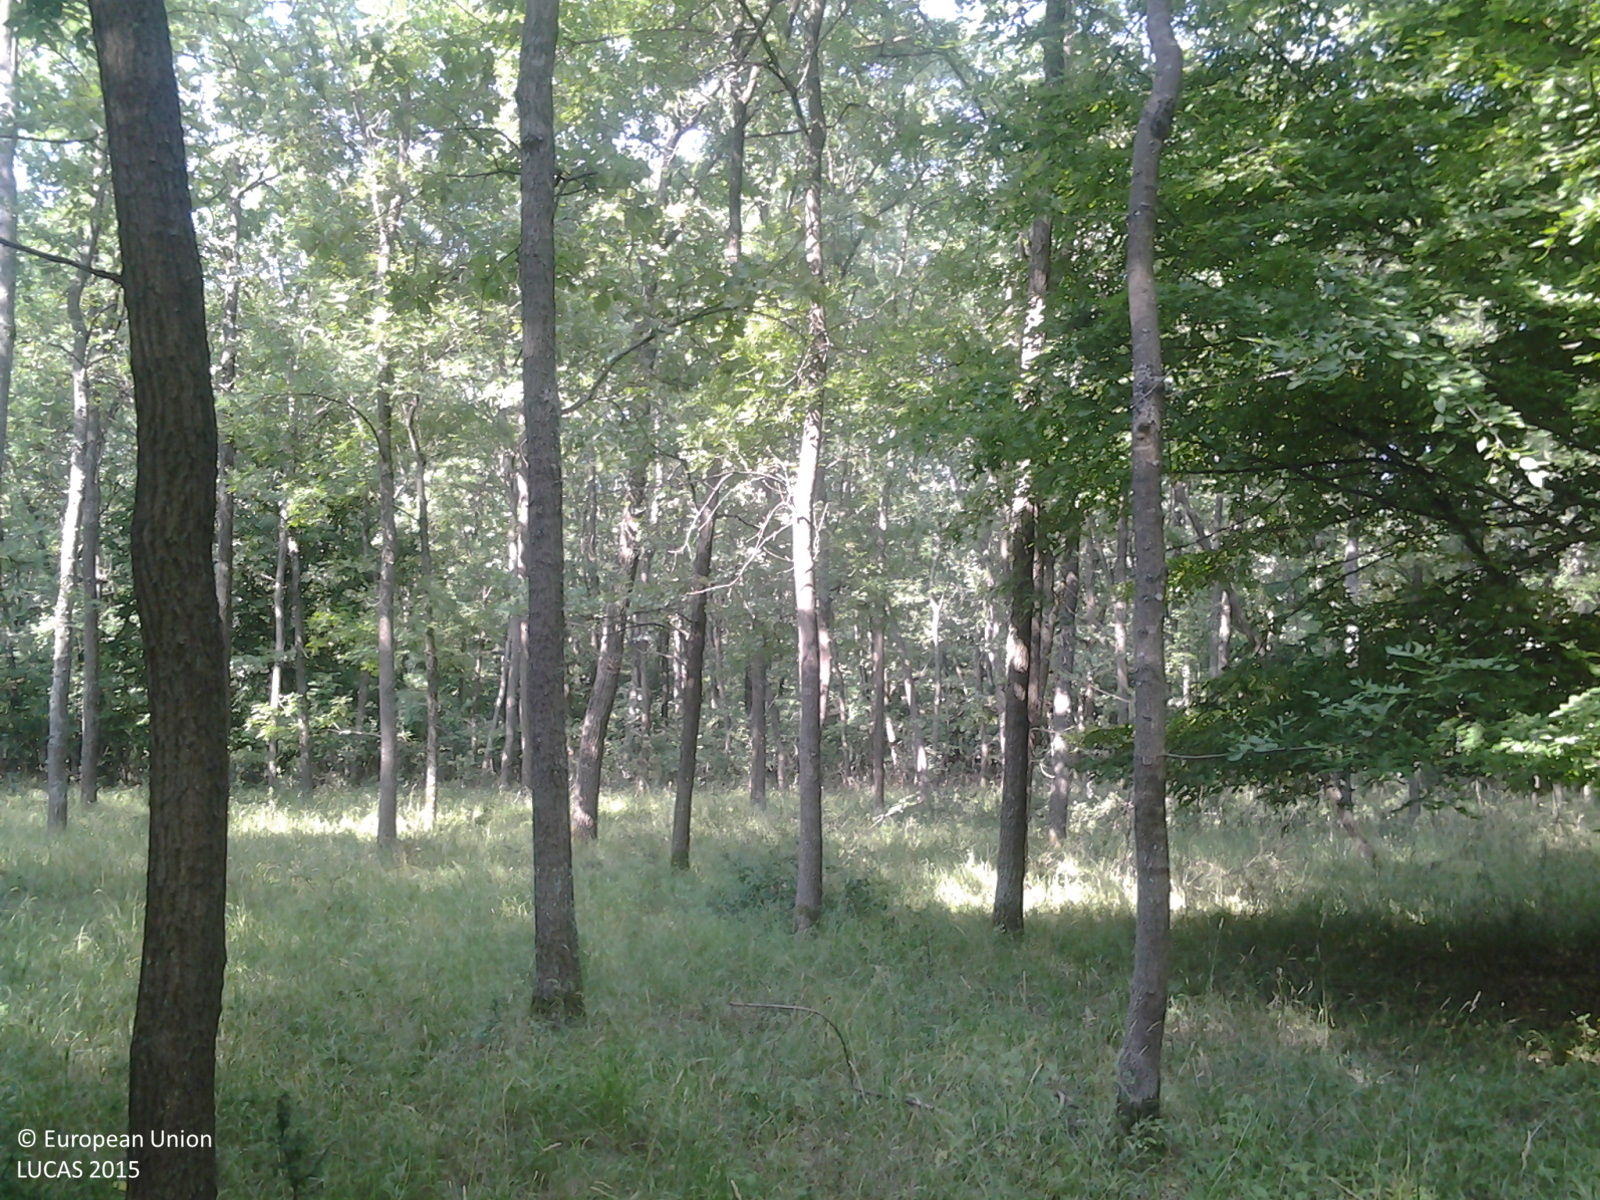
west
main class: Woodland
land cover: Broadleaved woodland
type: mesophytic deciduous forest
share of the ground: > 75 %
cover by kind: broadleaved forest trees 90 %, herbaceous plants 10 %
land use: Forestry
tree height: > 5 m
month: July
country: HU
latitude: 46.6617
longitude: 21.4472
